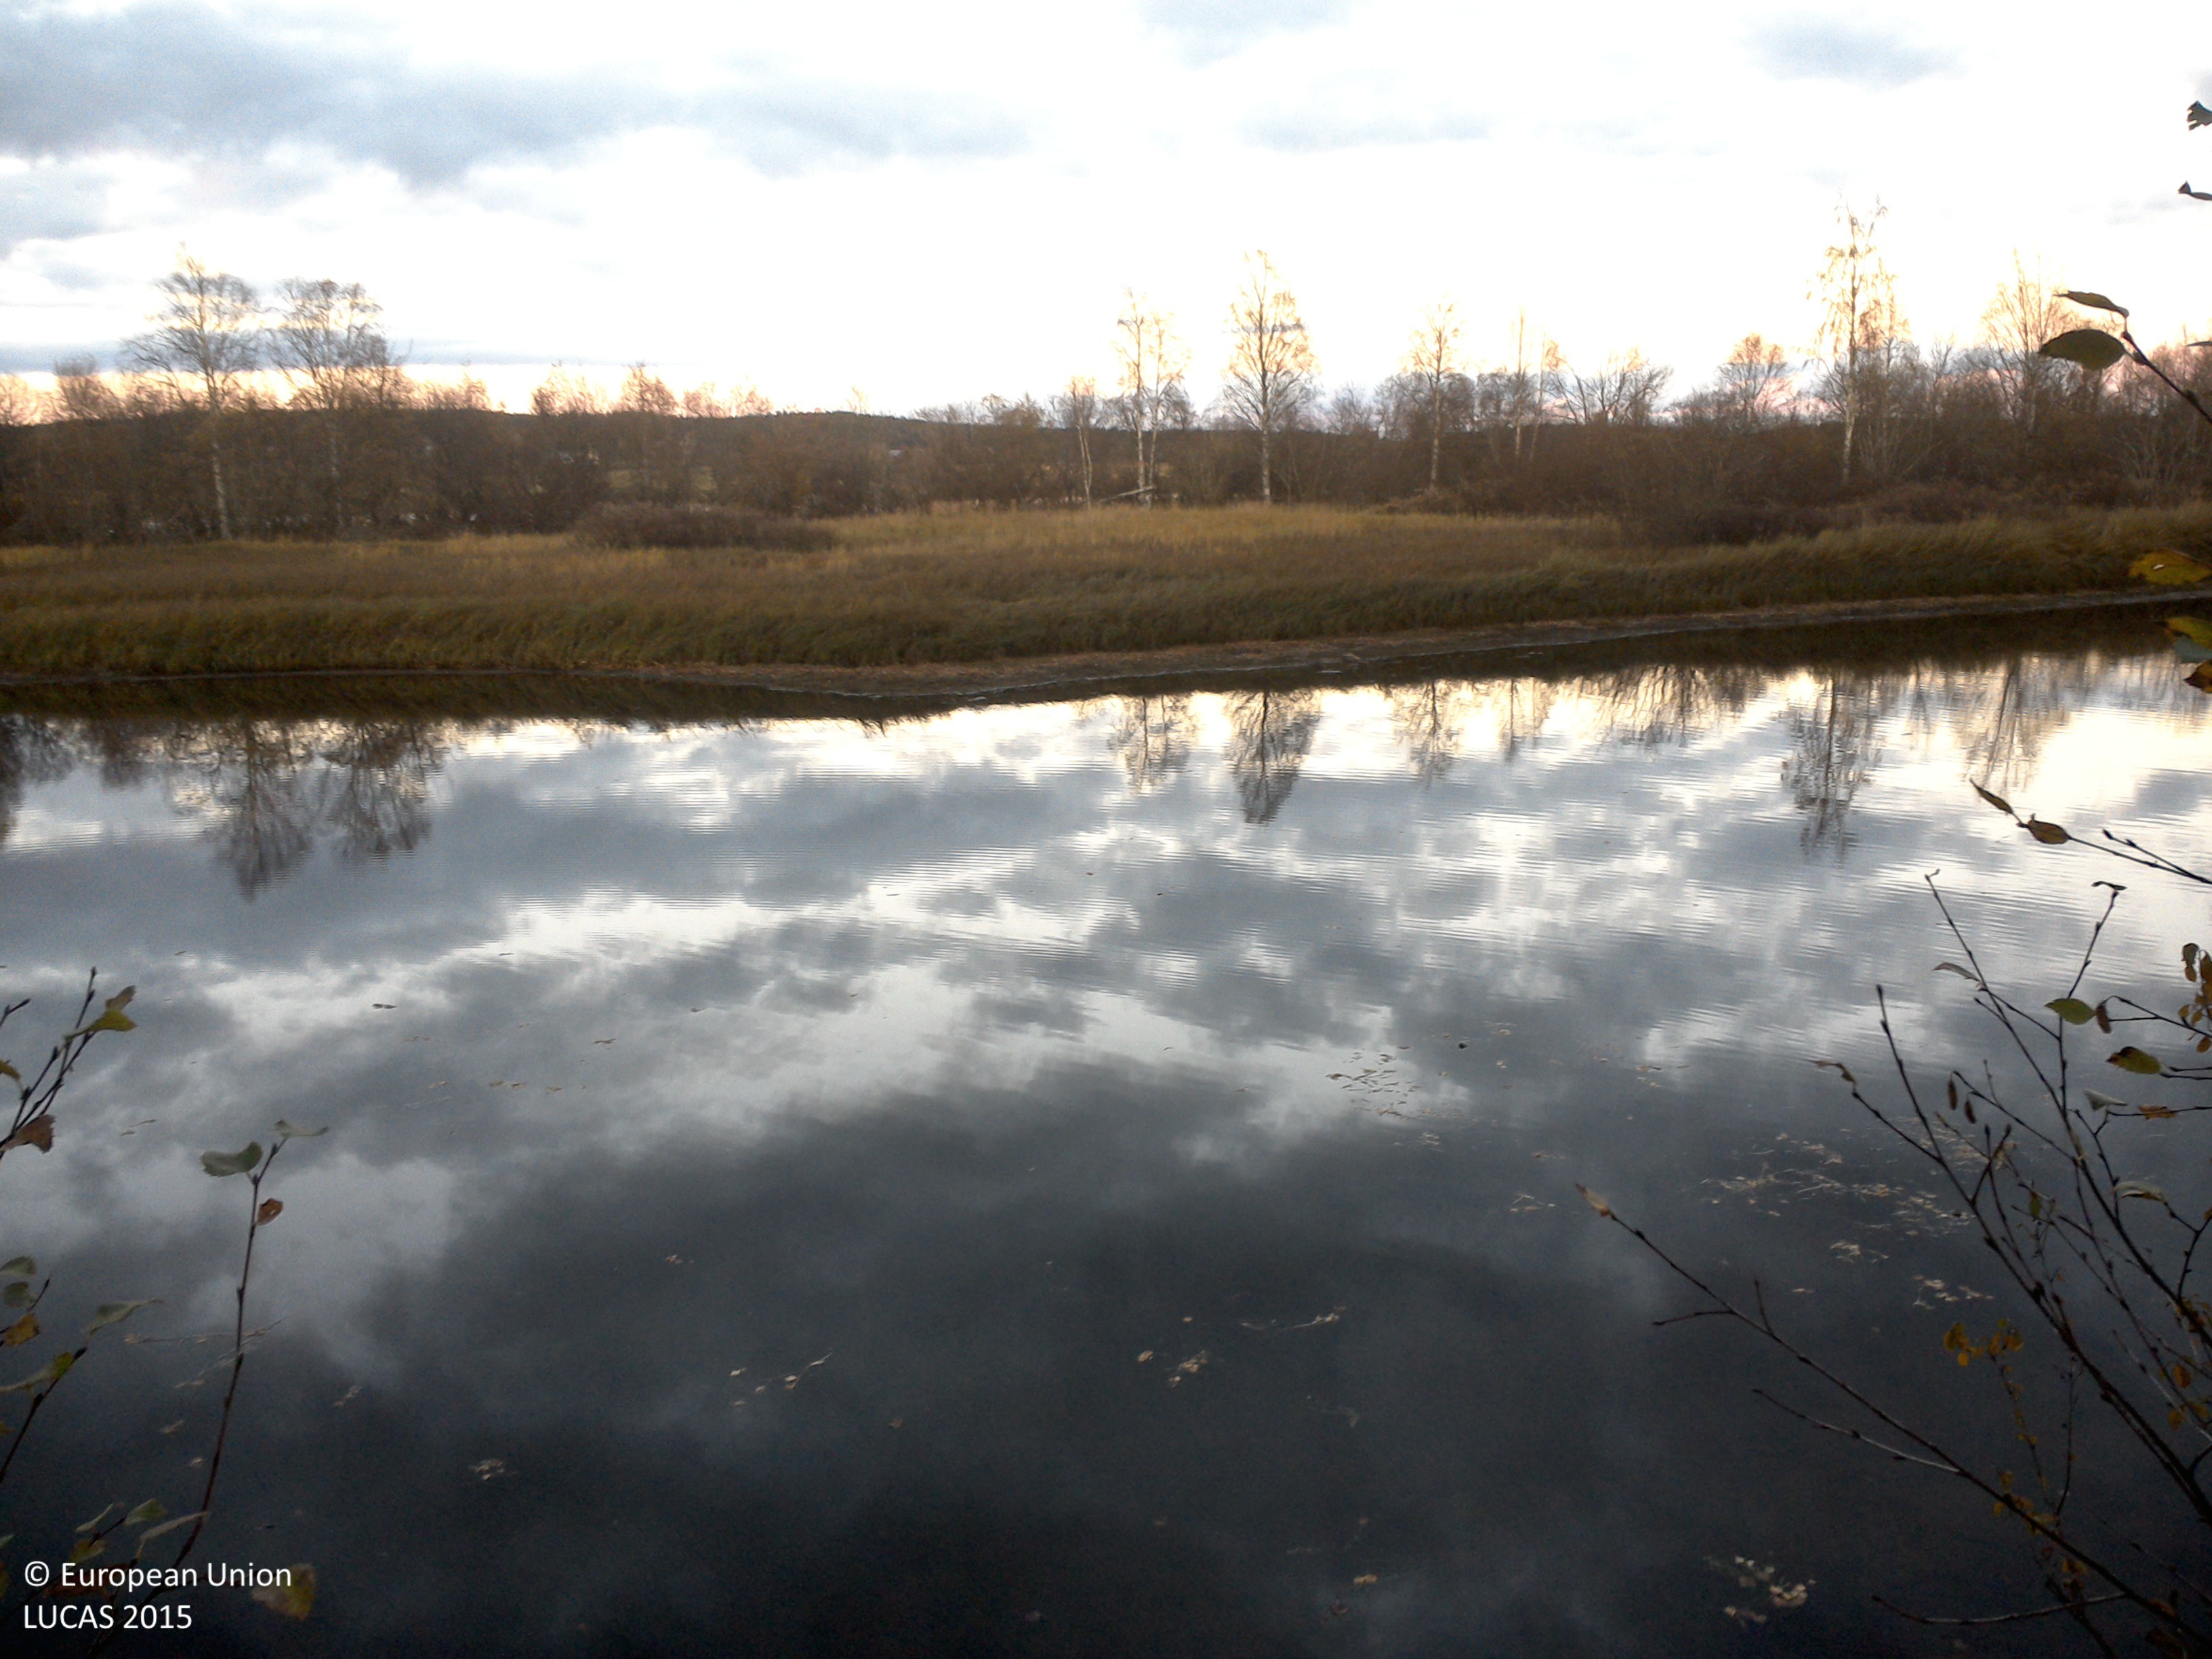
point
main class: Woodland
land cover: Broadleaved woodland
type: boreal forest
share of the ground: 25 - 50 %
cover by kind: herbaceous plants 60 %, broadleaved forest trees 40 %
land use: Semi-natural and natural areas not in use
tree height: > 5 m
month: October
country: SE
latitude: 63.8880
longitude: 19.8965
